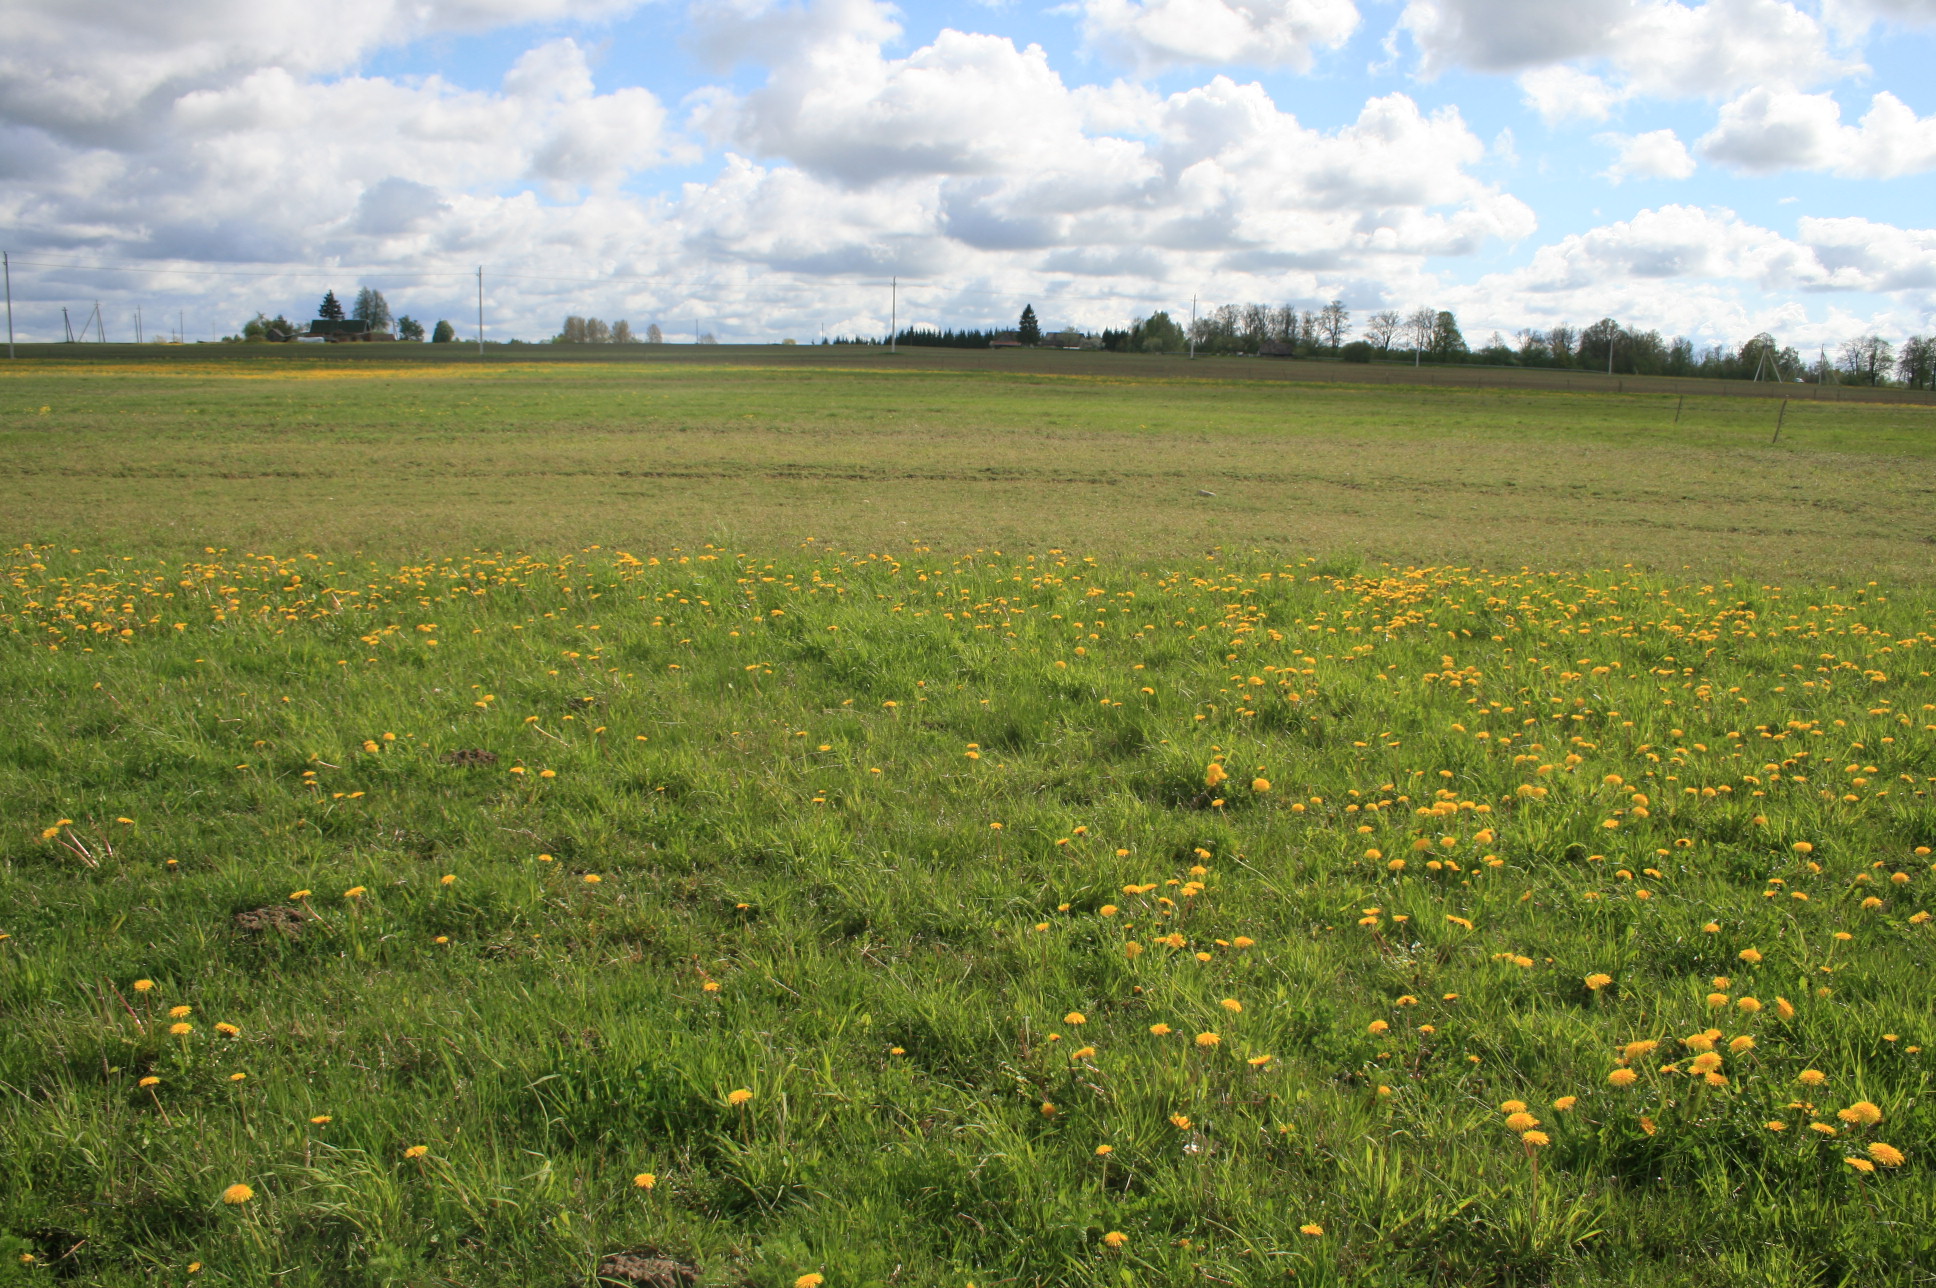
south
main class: Grassland
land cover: Grassland without tree/shrub cover
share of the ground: > 75 %
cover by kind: herbaceous plants 100 %
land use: Agriculture (excluding fallow land and kitchen gardens)
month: May
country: LT
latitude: 56.1960
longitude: 22.0910
